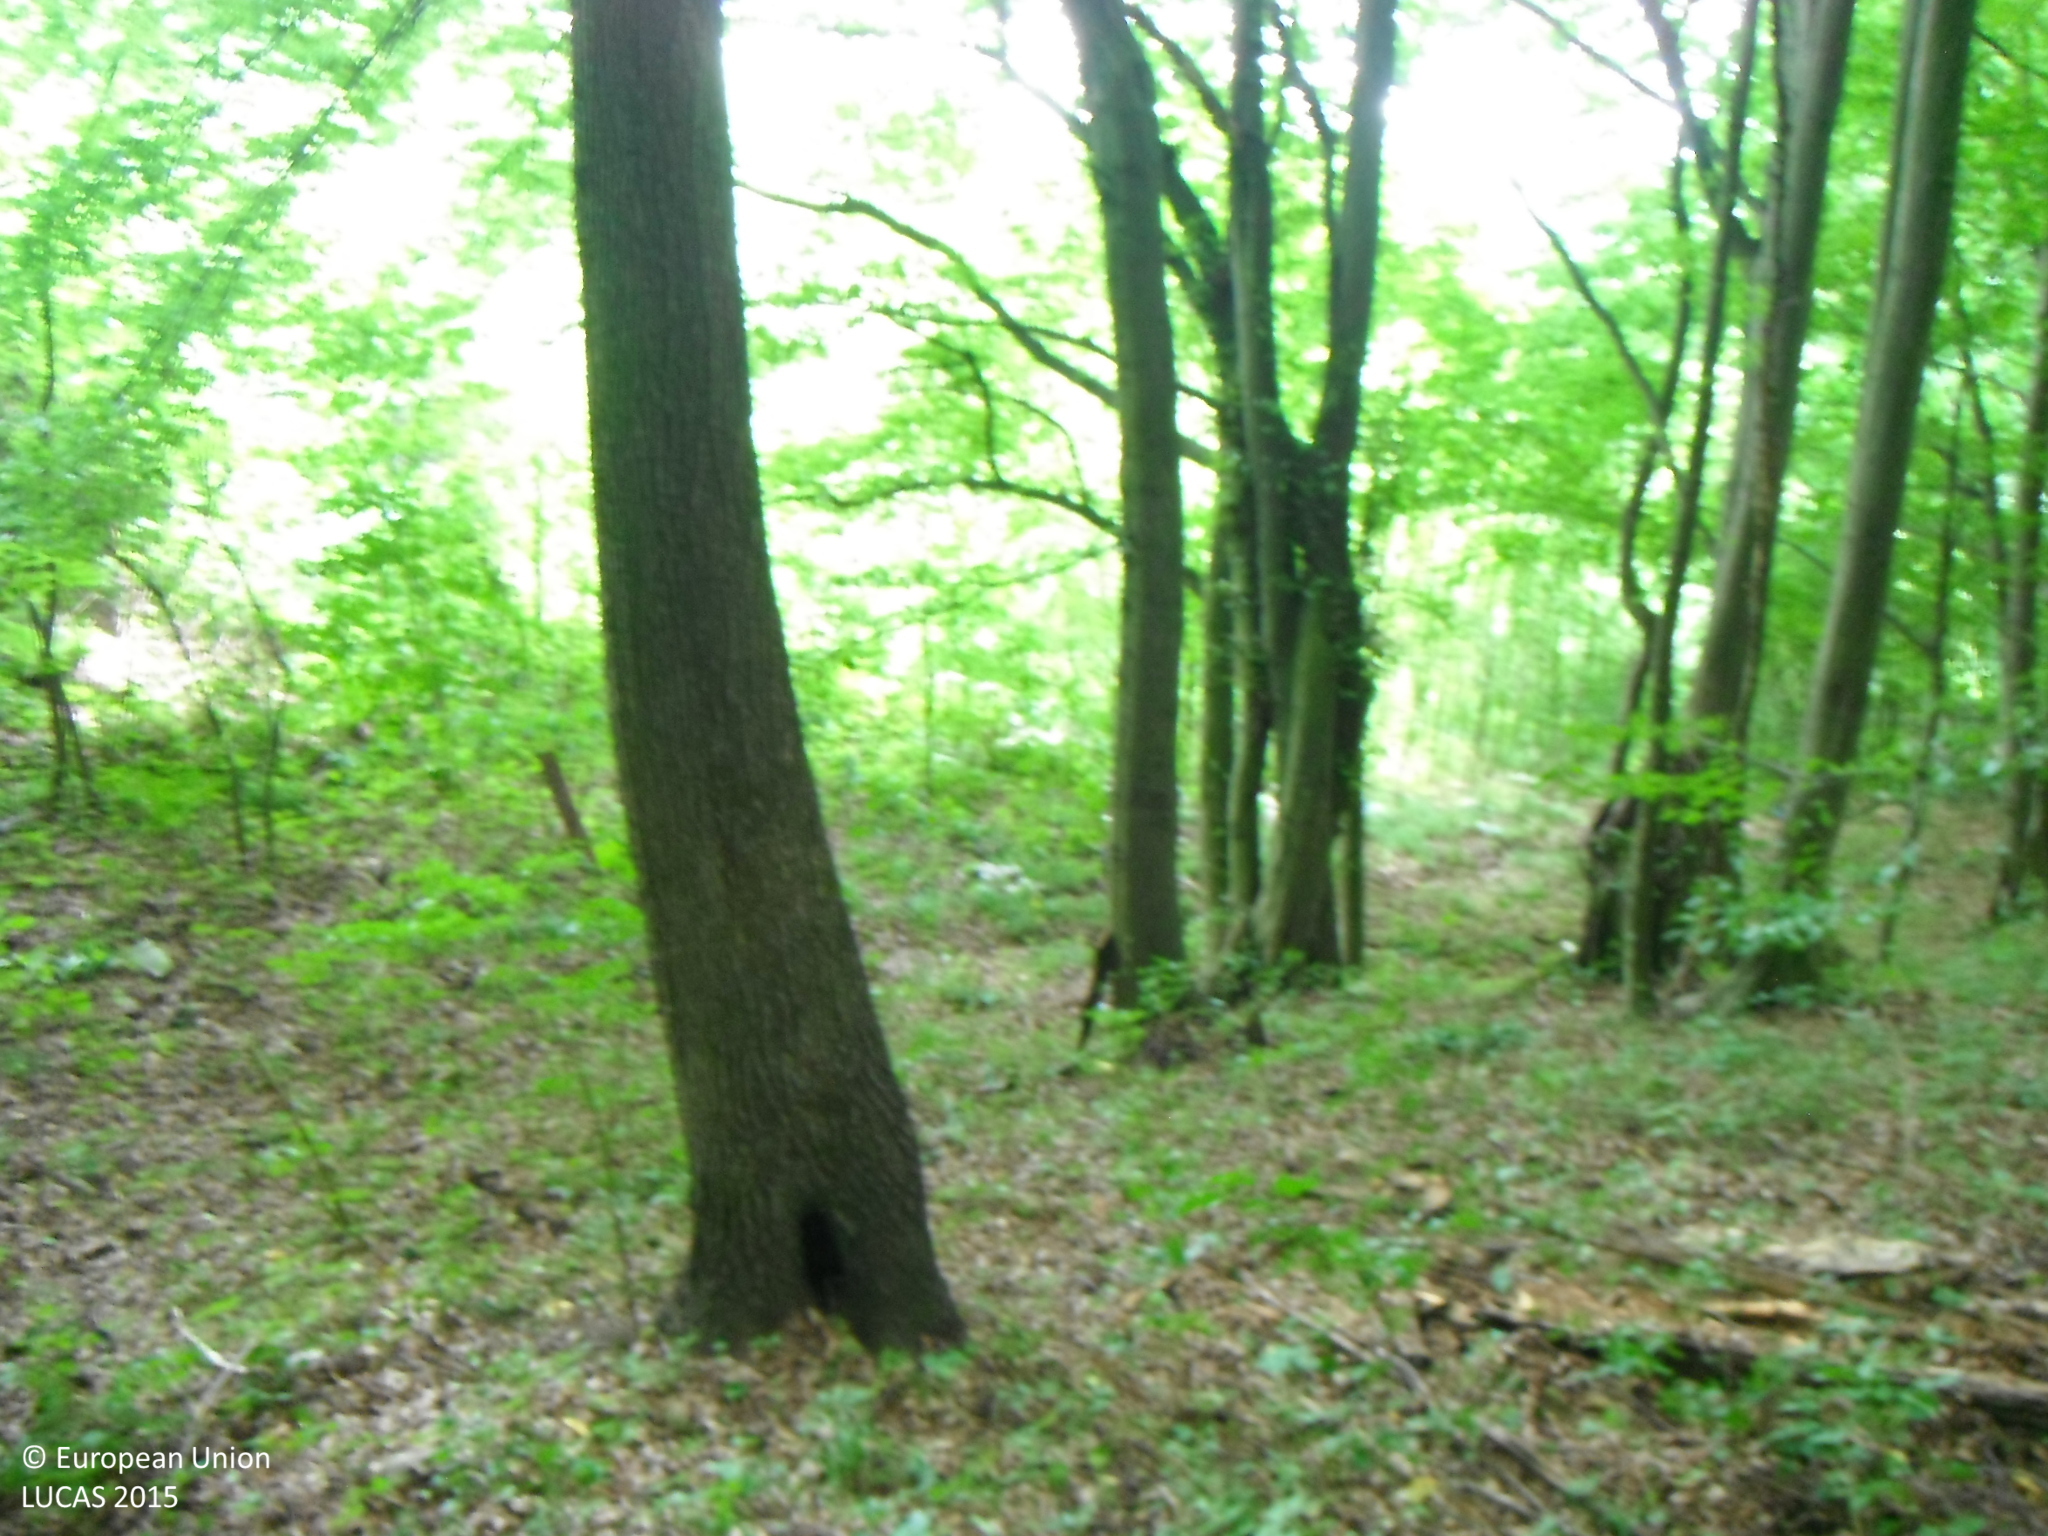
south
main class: Woodland
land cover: Broadleaved woodland
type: mesophytic deciduous forest
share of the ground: > 75 %
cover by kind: broadleaved forest trees 90 %, shrubs 5 %, herbaceous plants 5 %
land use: Forestry
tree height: > 5 m
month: June
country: SK
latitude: 48.5688
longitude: 19.9630
